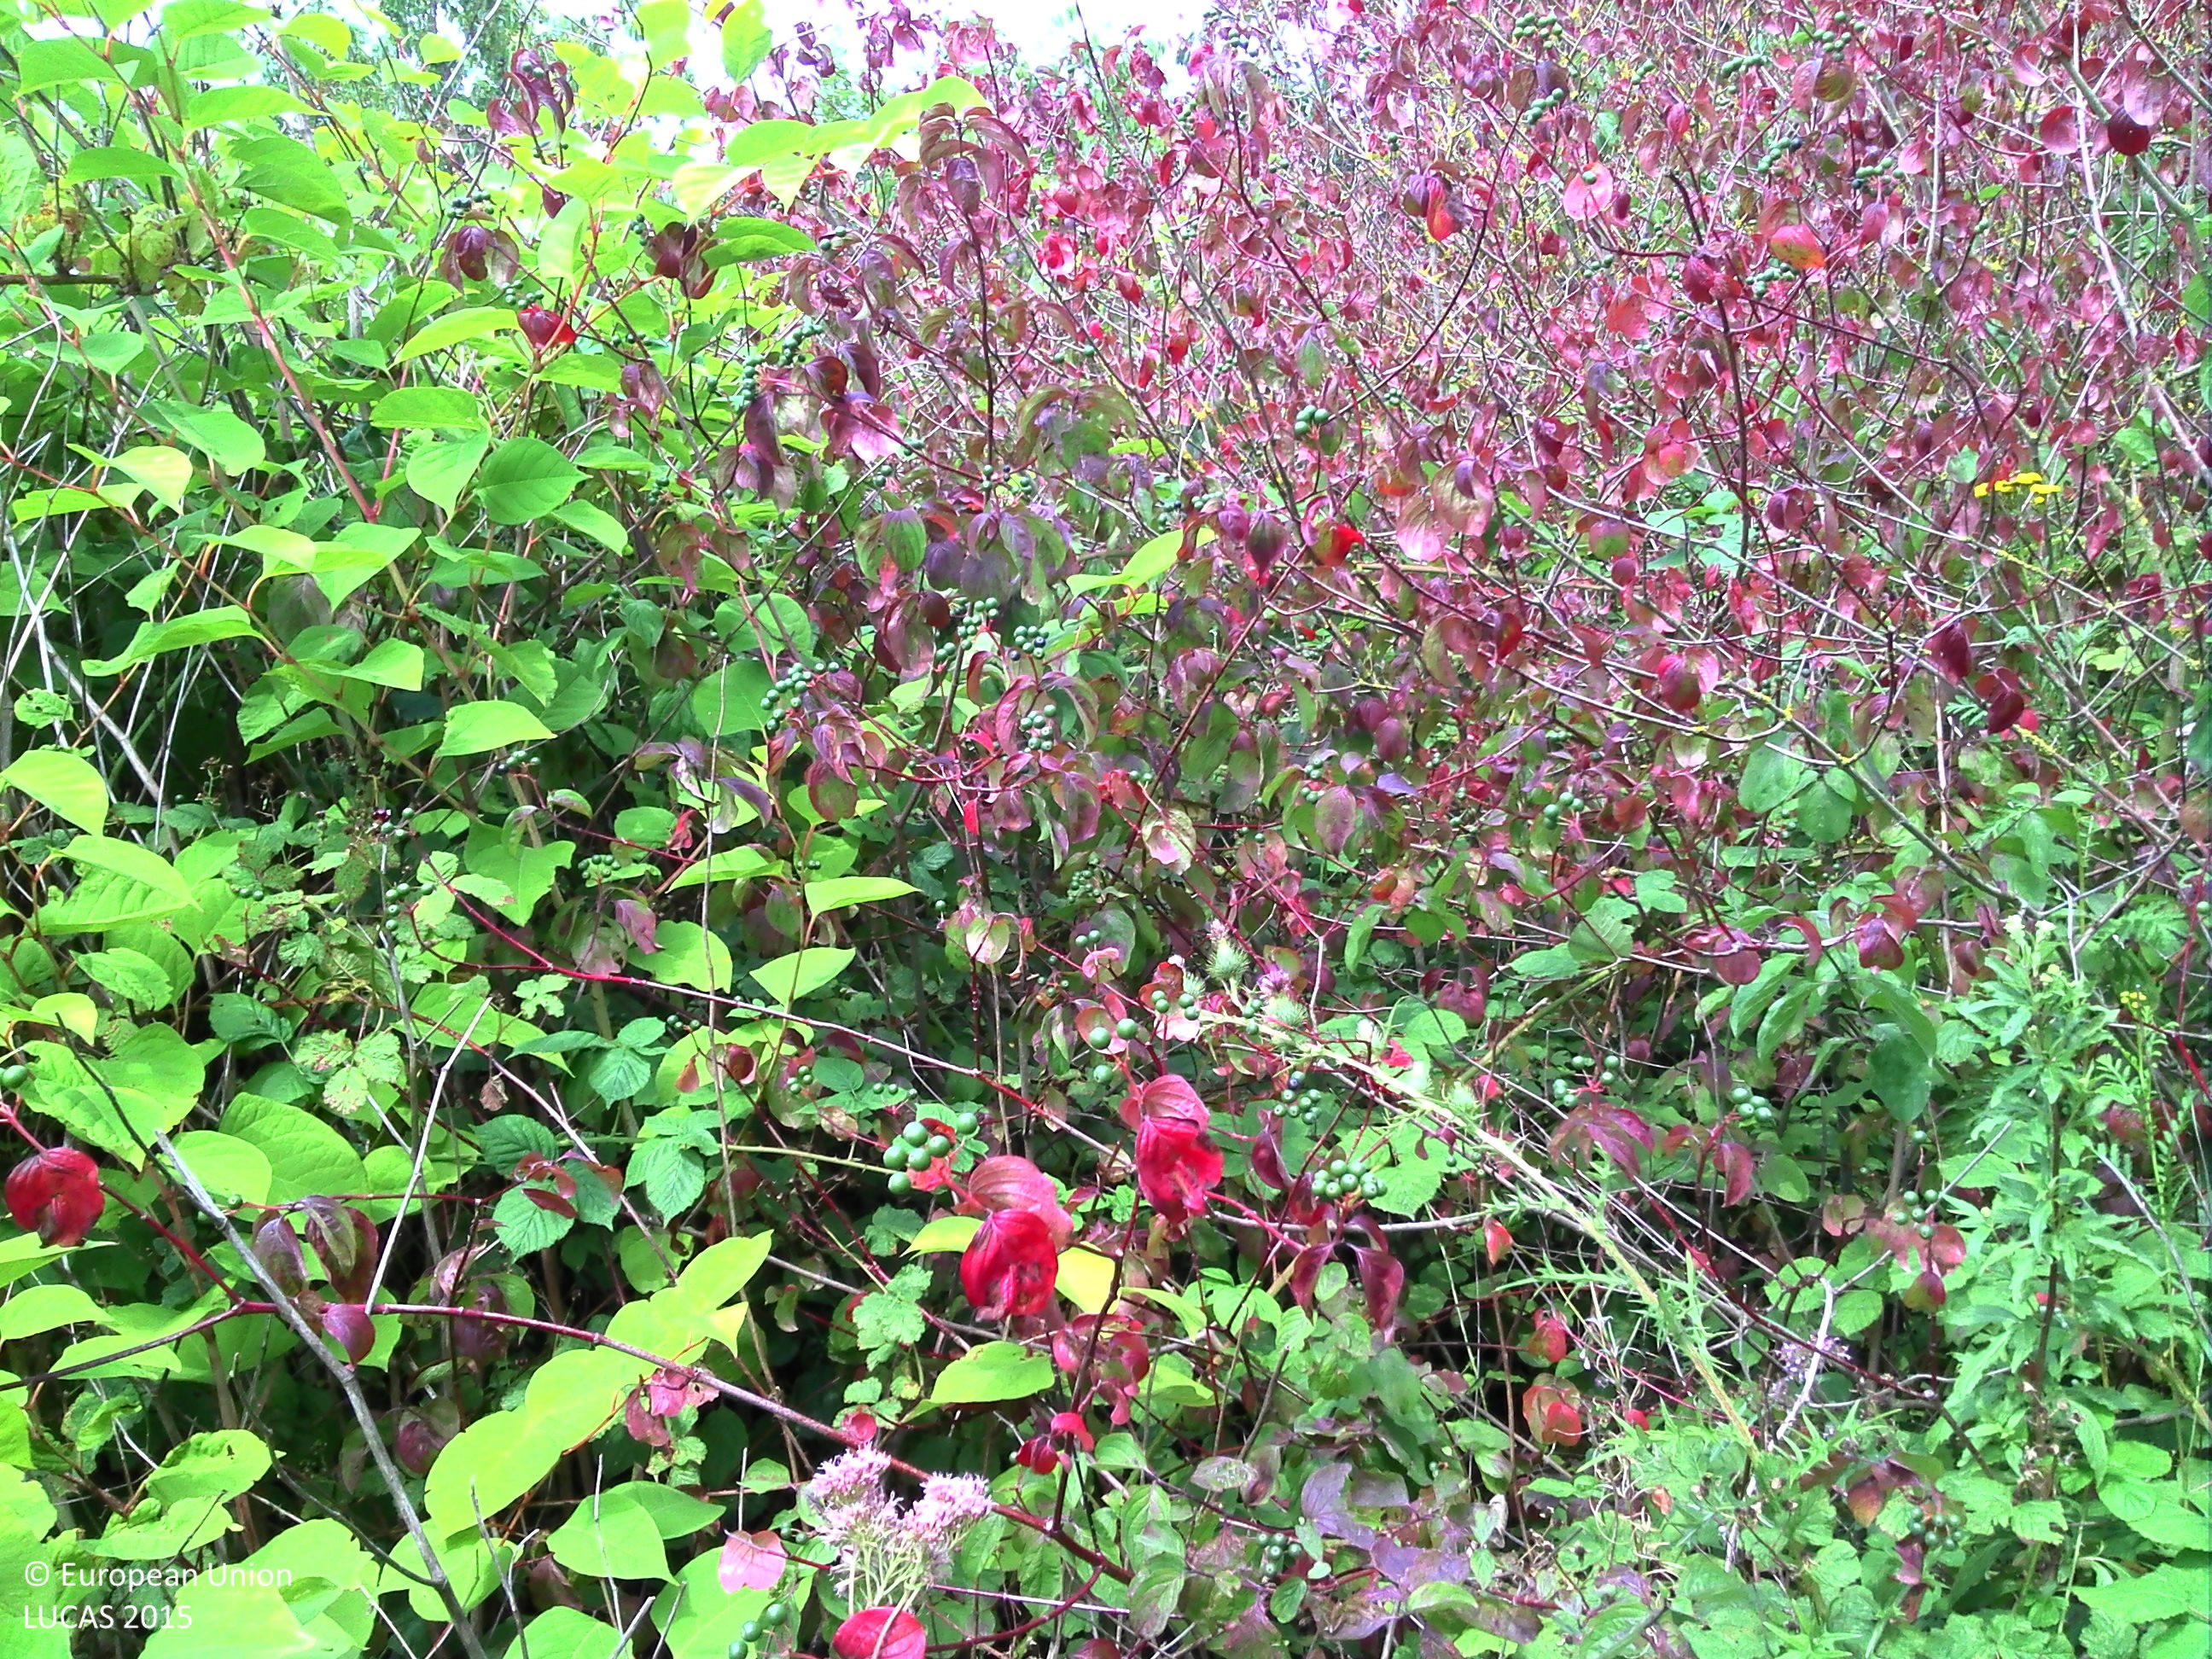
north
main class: Shrubland
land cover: Shrubland with sparse tree cover
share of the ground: > 75 %
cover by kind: shrubs 95 %, broadleaved forest trees 5 %
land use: Semi-natural and natural areas not in use
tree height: > 5 m
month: July
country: BE
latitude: 50.6353
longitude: 5.4879
